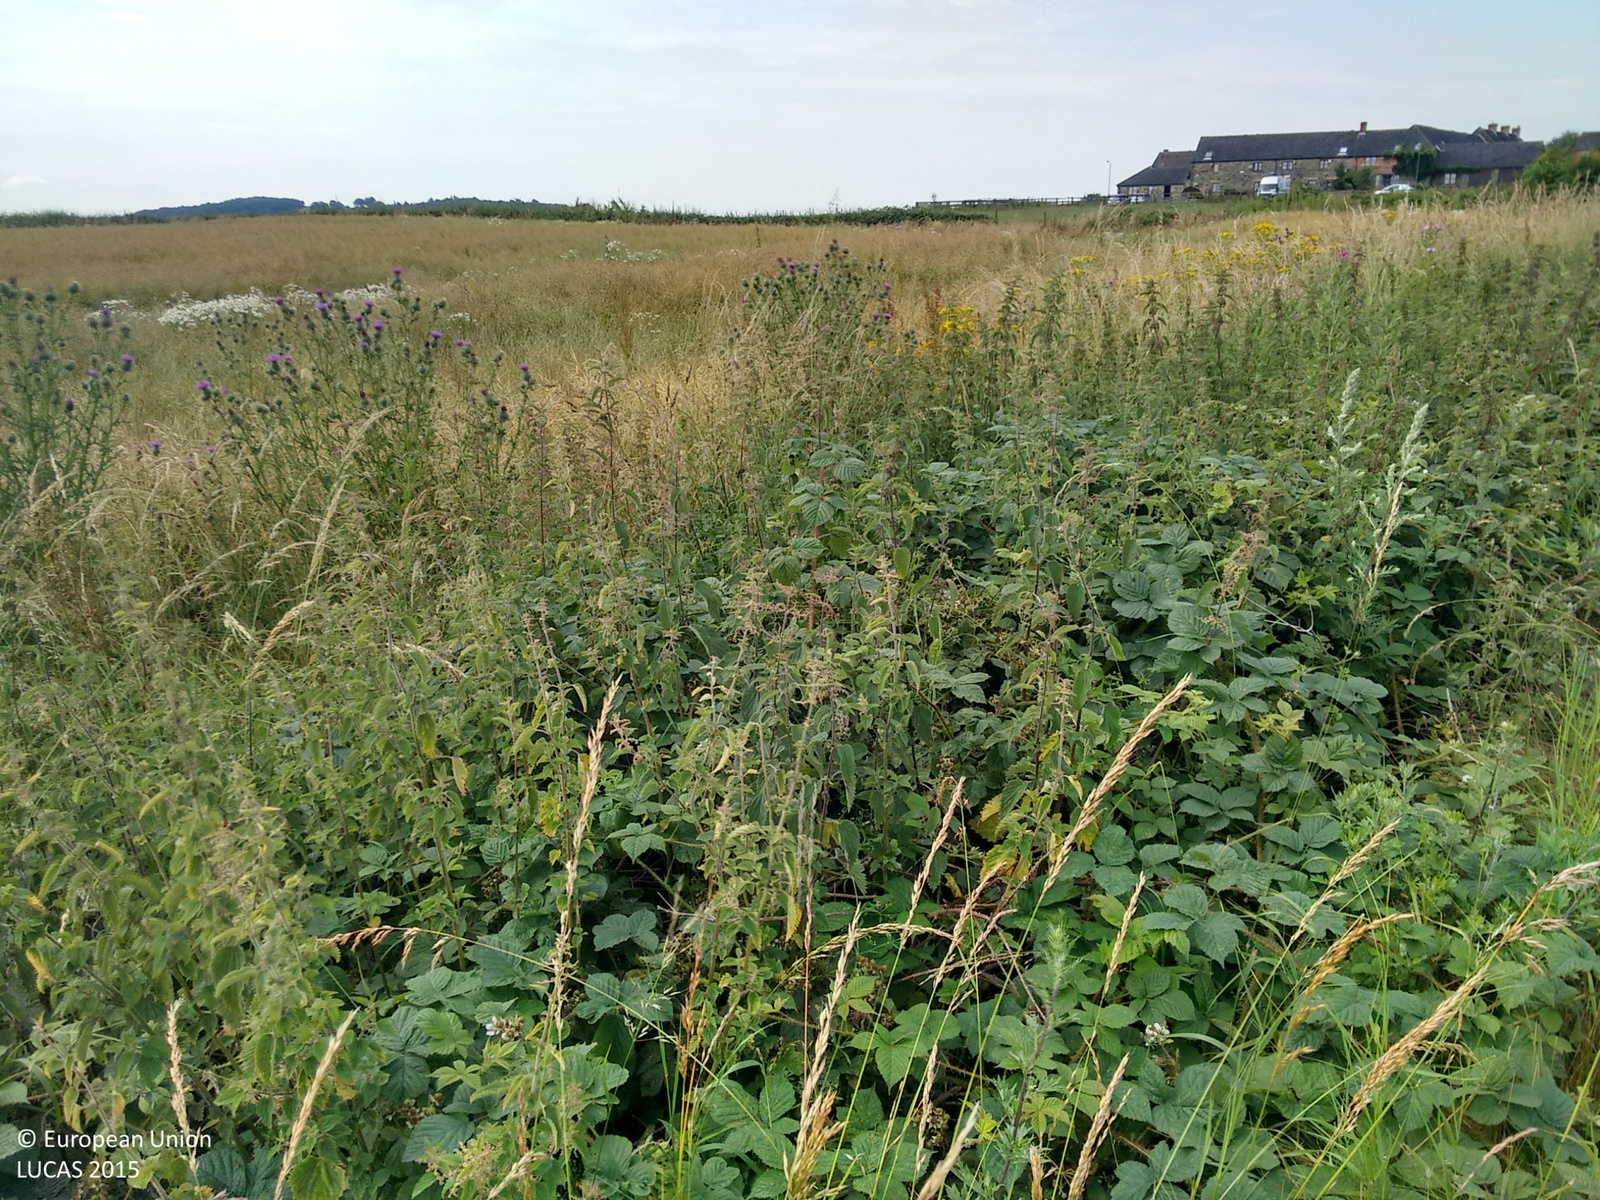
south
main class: Cropland
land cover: Rape and turnip rape
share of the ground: > 75 %
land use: Agriculture (excluding fallow land and kitchen gardens)
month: July
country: GB
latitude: 53.0376
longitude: -1.4588
